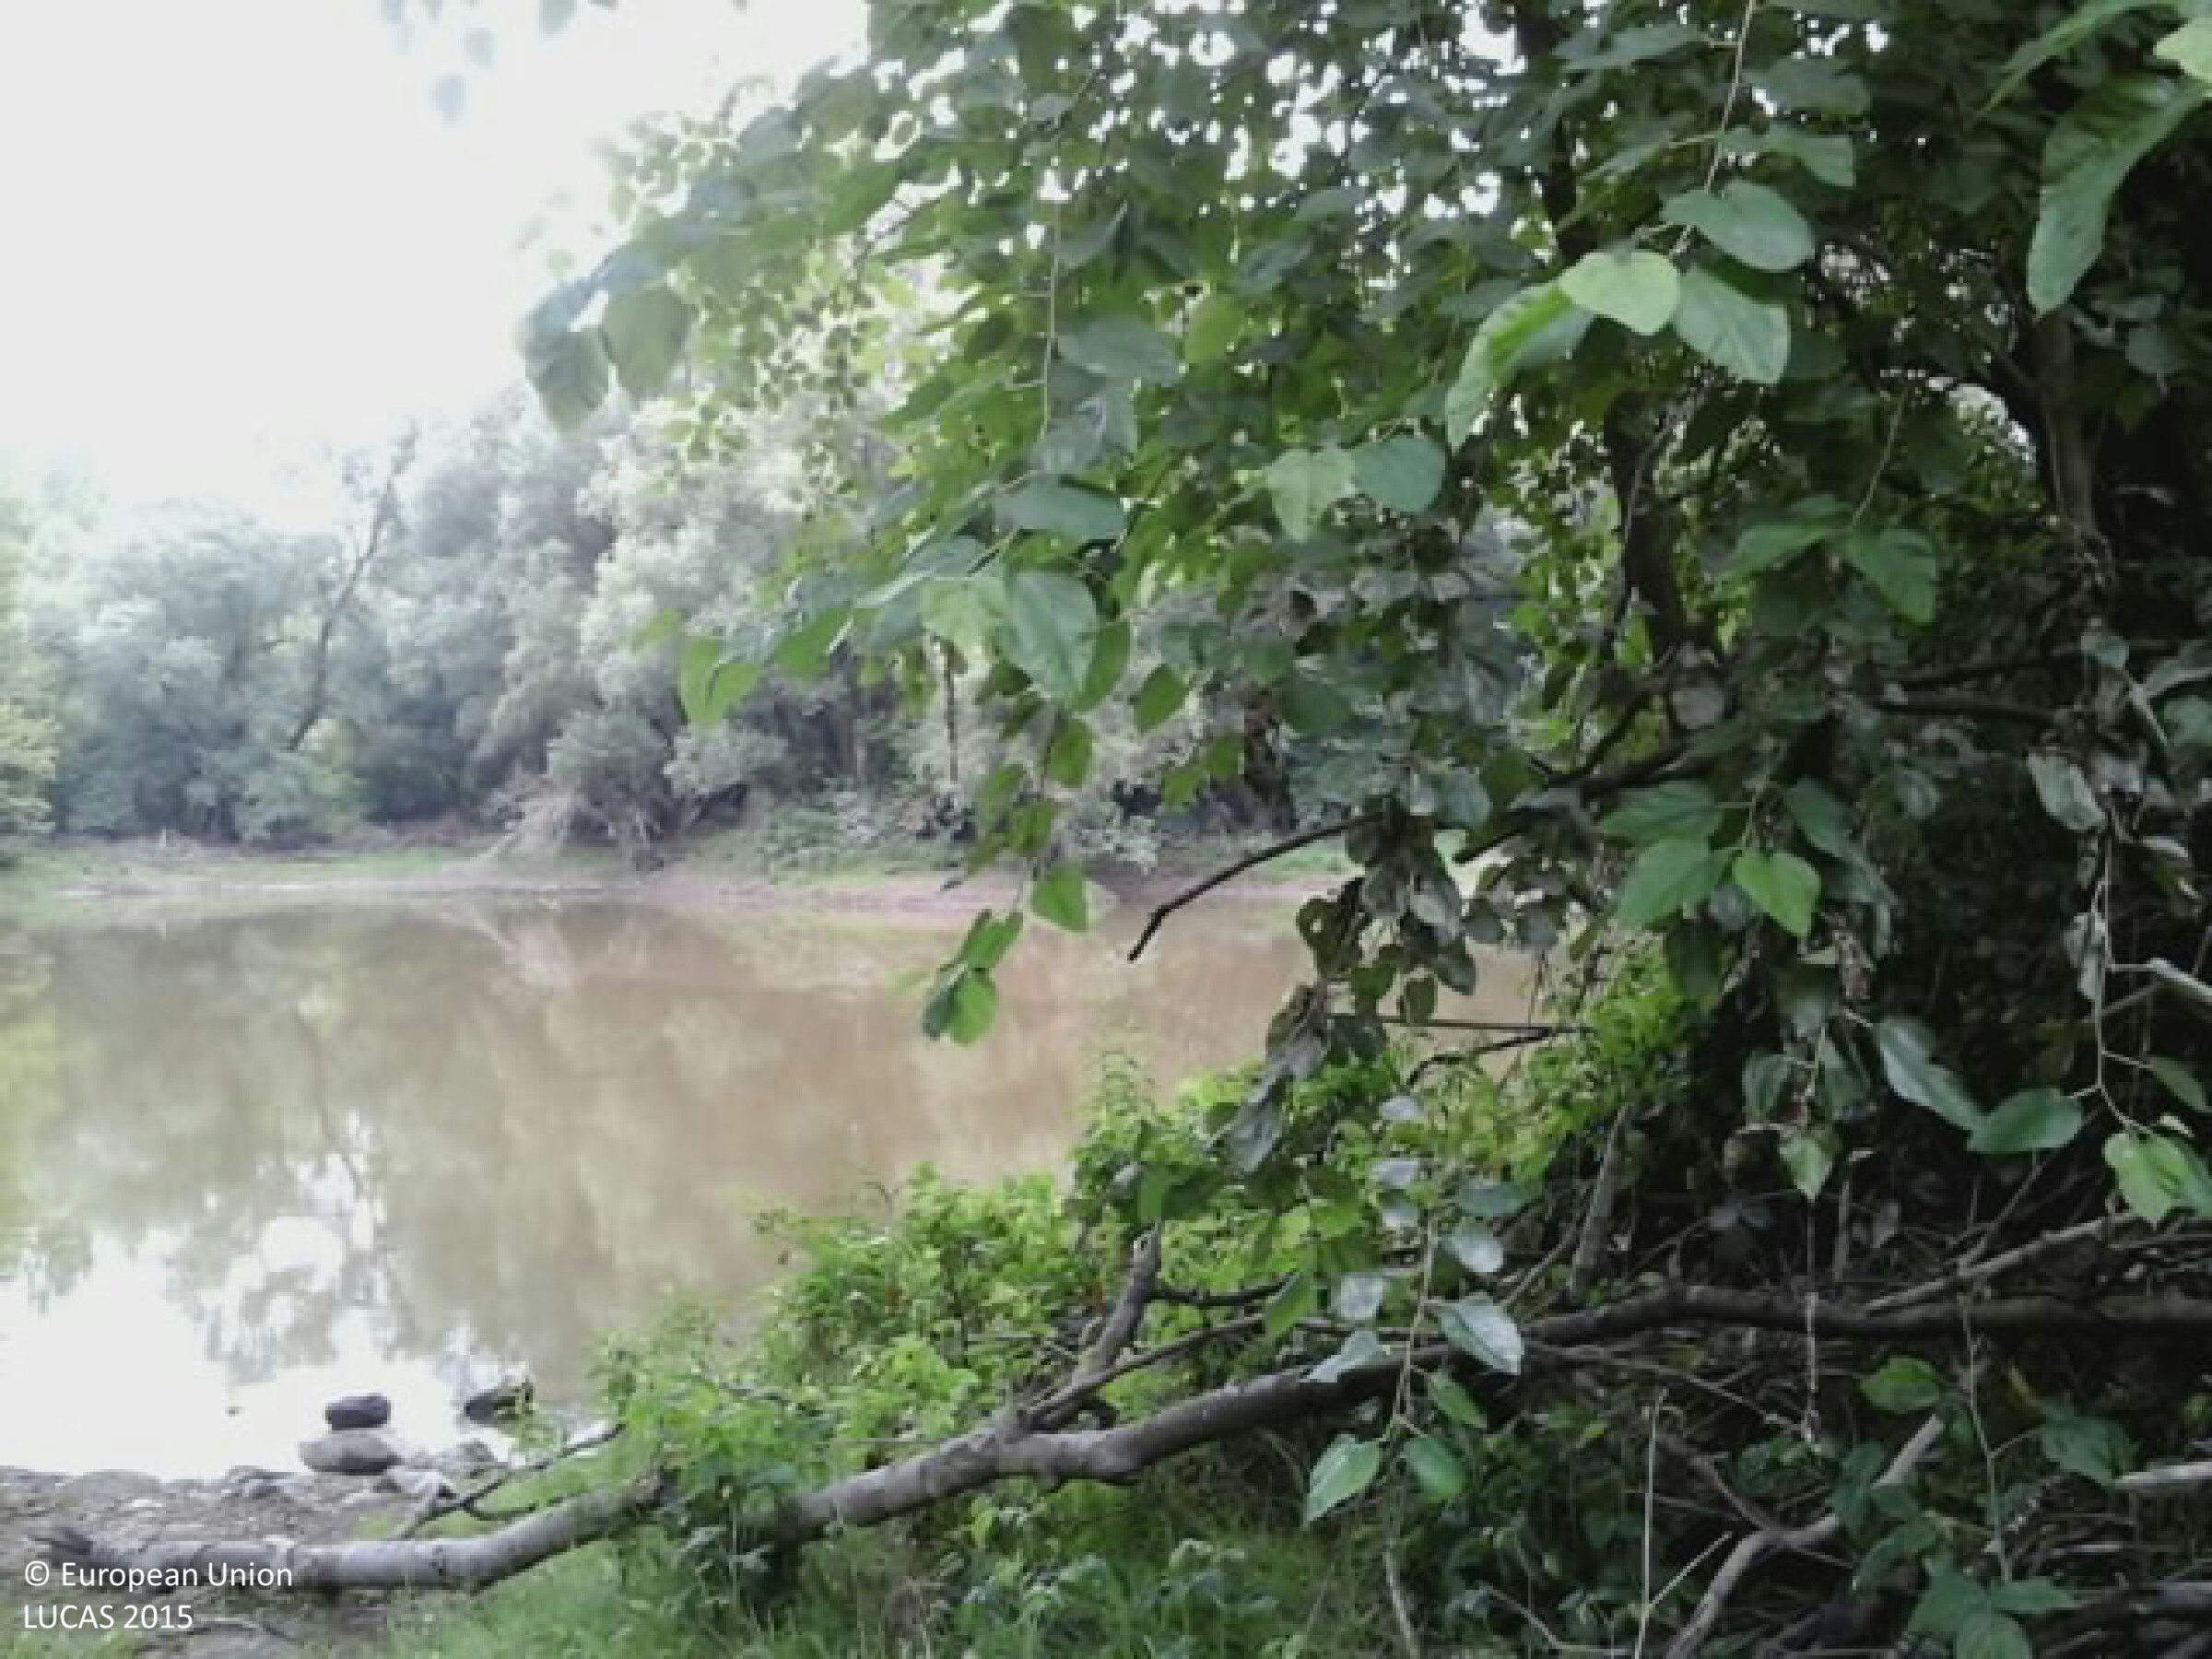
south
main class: Woodland
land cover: Broadleaved woodland
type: mesophytic deciduous forest
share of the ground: 50 - 75 %
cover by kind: broadleaved forest trees 60 %, shrubs 15 %, herbaceous plants 15 %, unconsolidated bare surface 10 %
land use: Forestry
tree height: > 5 m
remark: Temporary dry
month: July
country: HU
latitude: 46.4860
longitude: 18.9103
